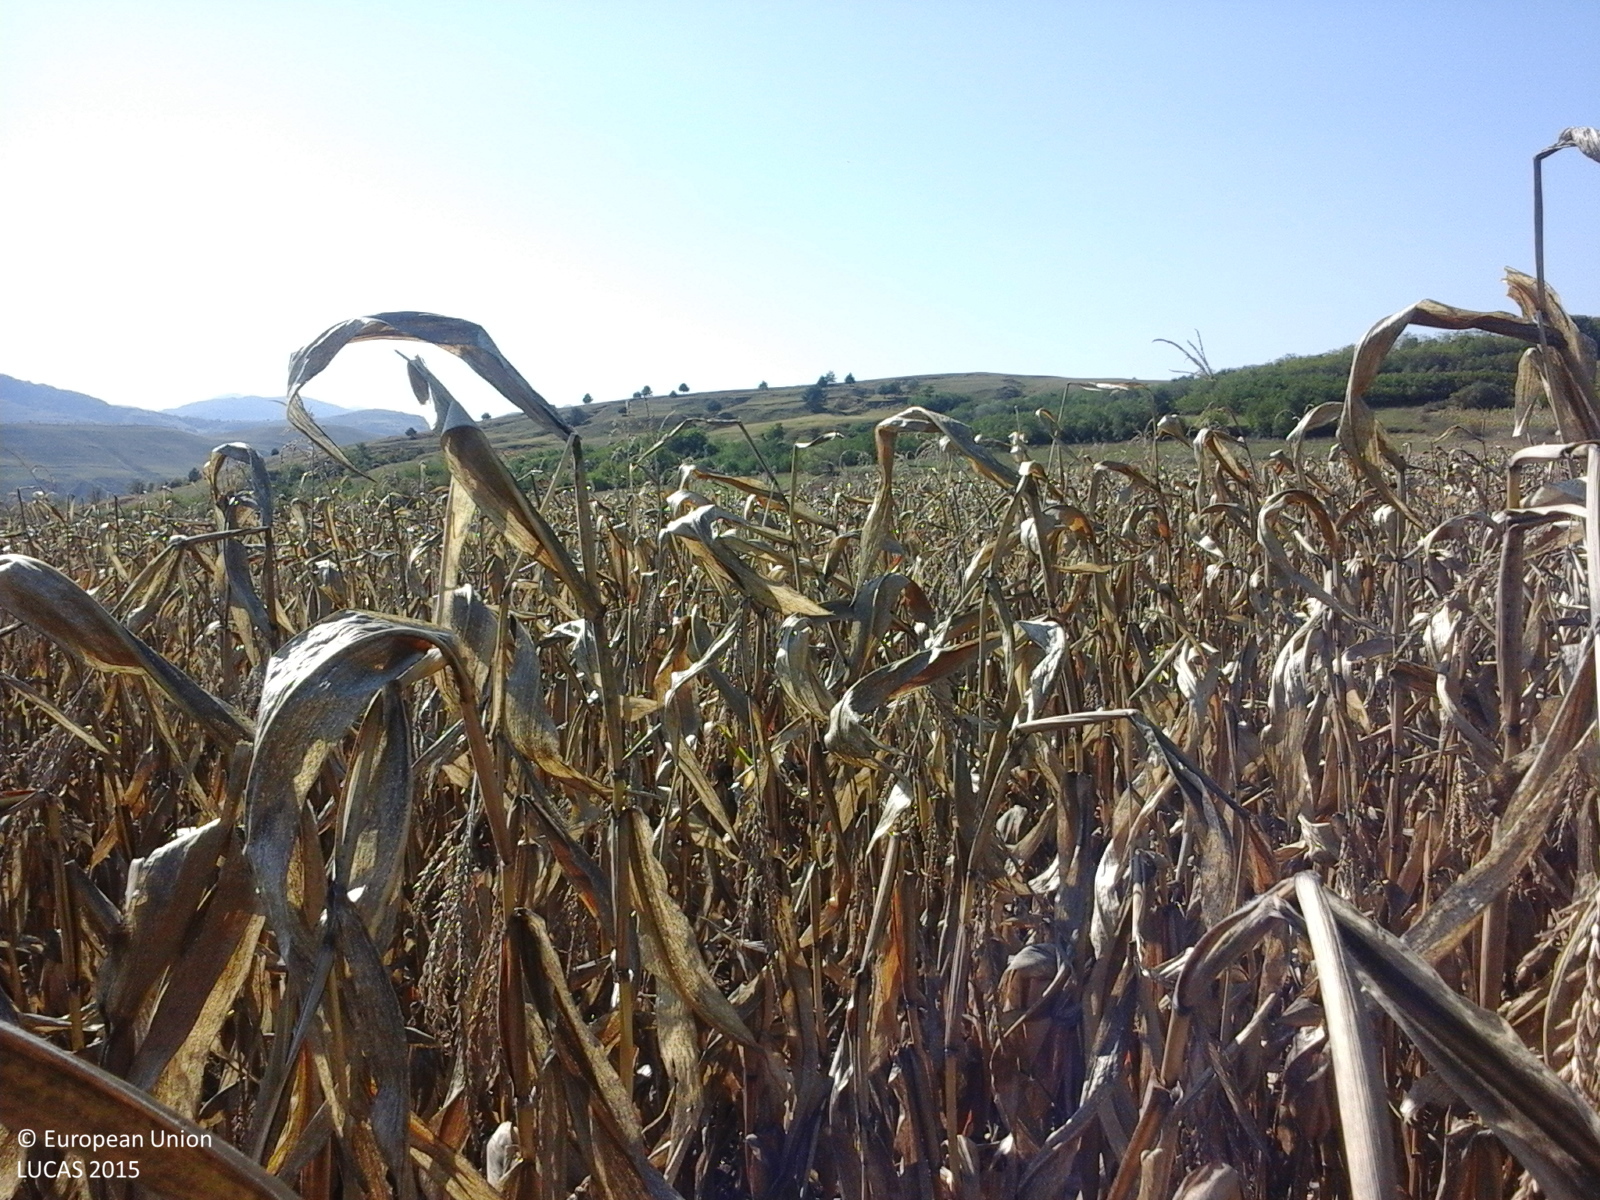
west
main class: Cropland
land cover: Maize
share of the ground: > 75 %
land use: Agriculture (excluding fallow land and kitchen gardens)
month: October
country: RO
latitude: 46.2627
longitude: 23.5998
